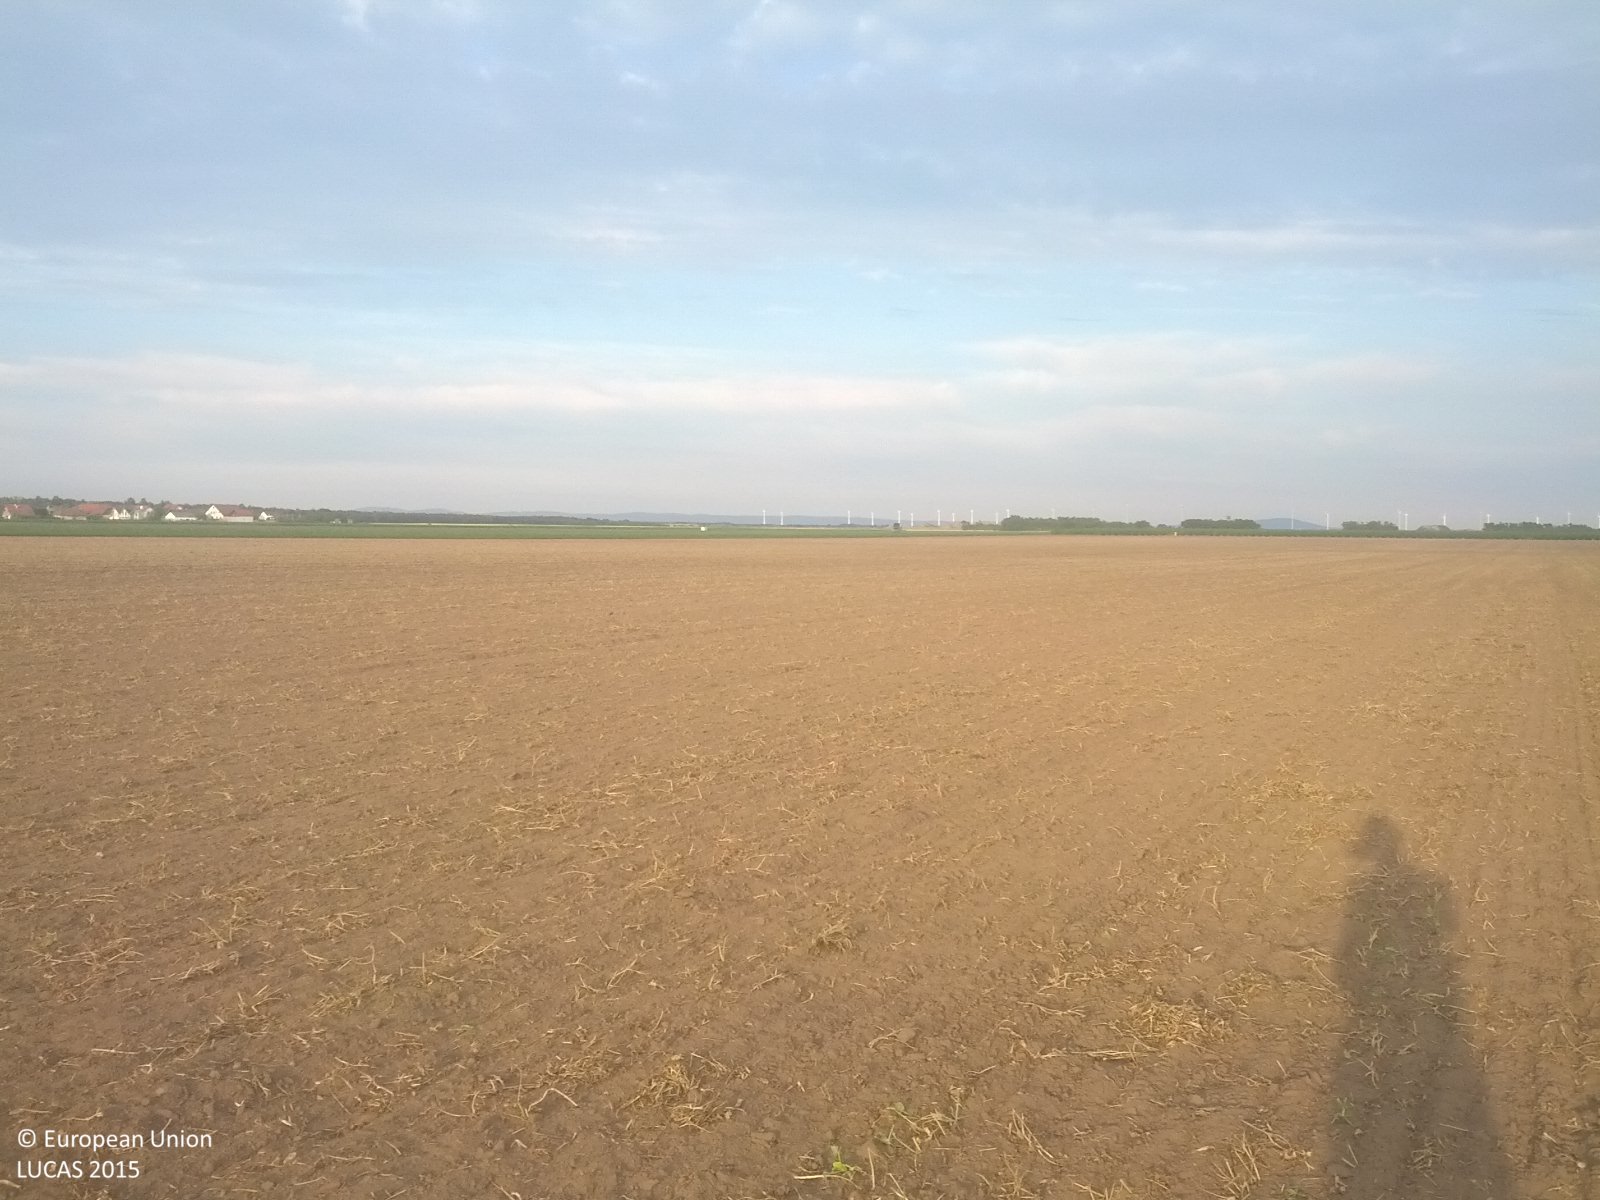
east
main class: Cropland
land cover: Dry pulses
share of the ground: < 10 %
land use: Agriculture (excluding fallow land and kitchen gardens)
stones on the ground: 10 - 25 %
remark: Harvested field
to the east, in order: Dry pulses
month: June
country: AT
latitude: 48.2983
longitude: 16.5708
